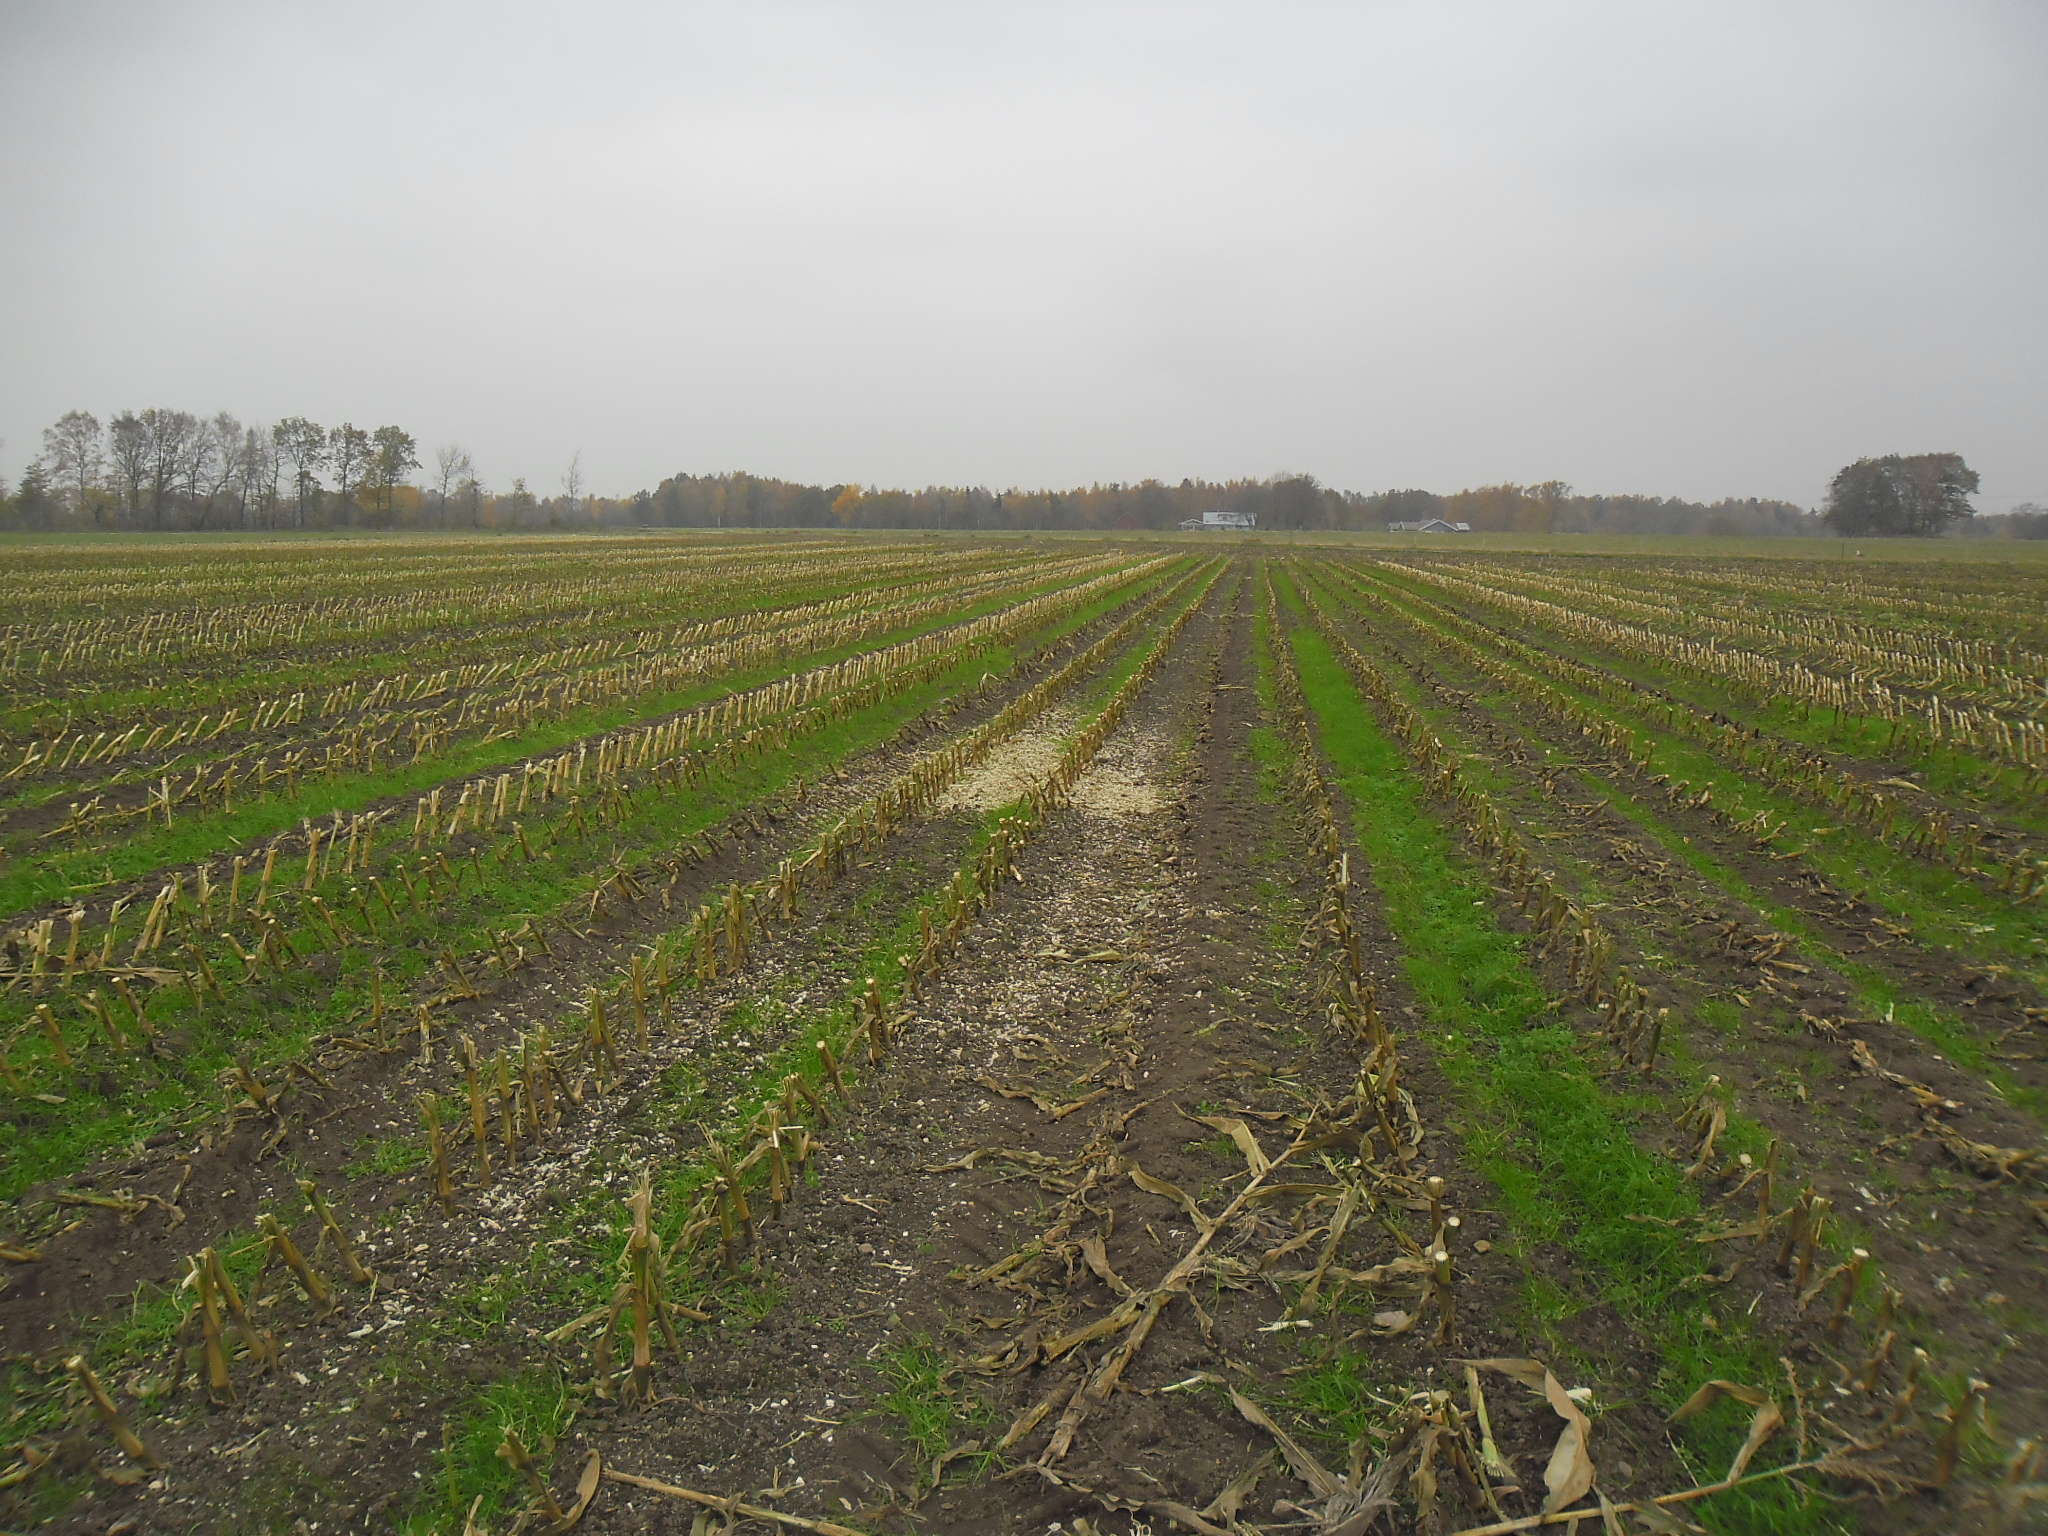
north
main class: Cropland
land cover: Maize
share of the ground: < 10 %
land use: Agriculture (excluding fallow land and kitchen gardens)
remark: Harvested field
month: October
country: SE
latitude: 56.4383
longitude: 13.0949
